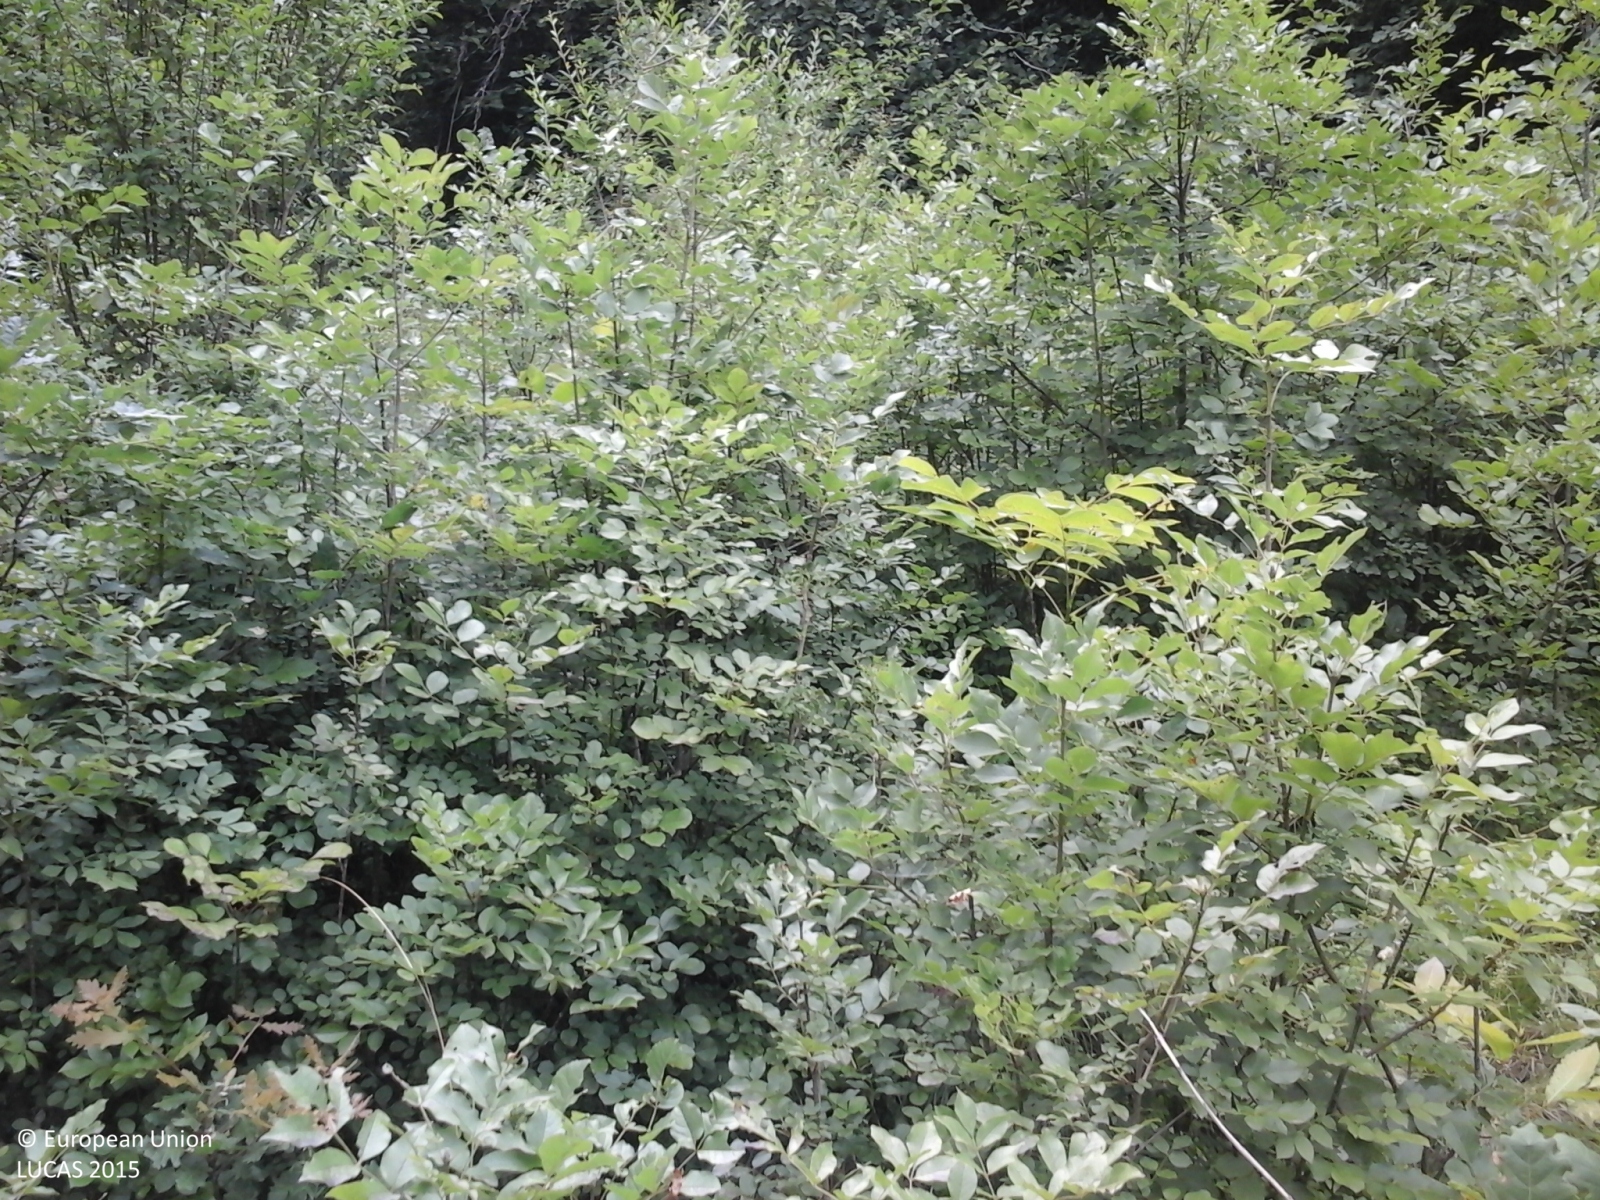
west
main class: Woodland
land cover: Broadleaved woodland
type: mesophytic deciduous forest
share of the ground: > 75 %
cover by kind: broadleaved forest trees 100 %
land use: Forestry
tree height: > 5 m
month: June
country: IT
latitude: 46.6634
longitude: 11.6057
